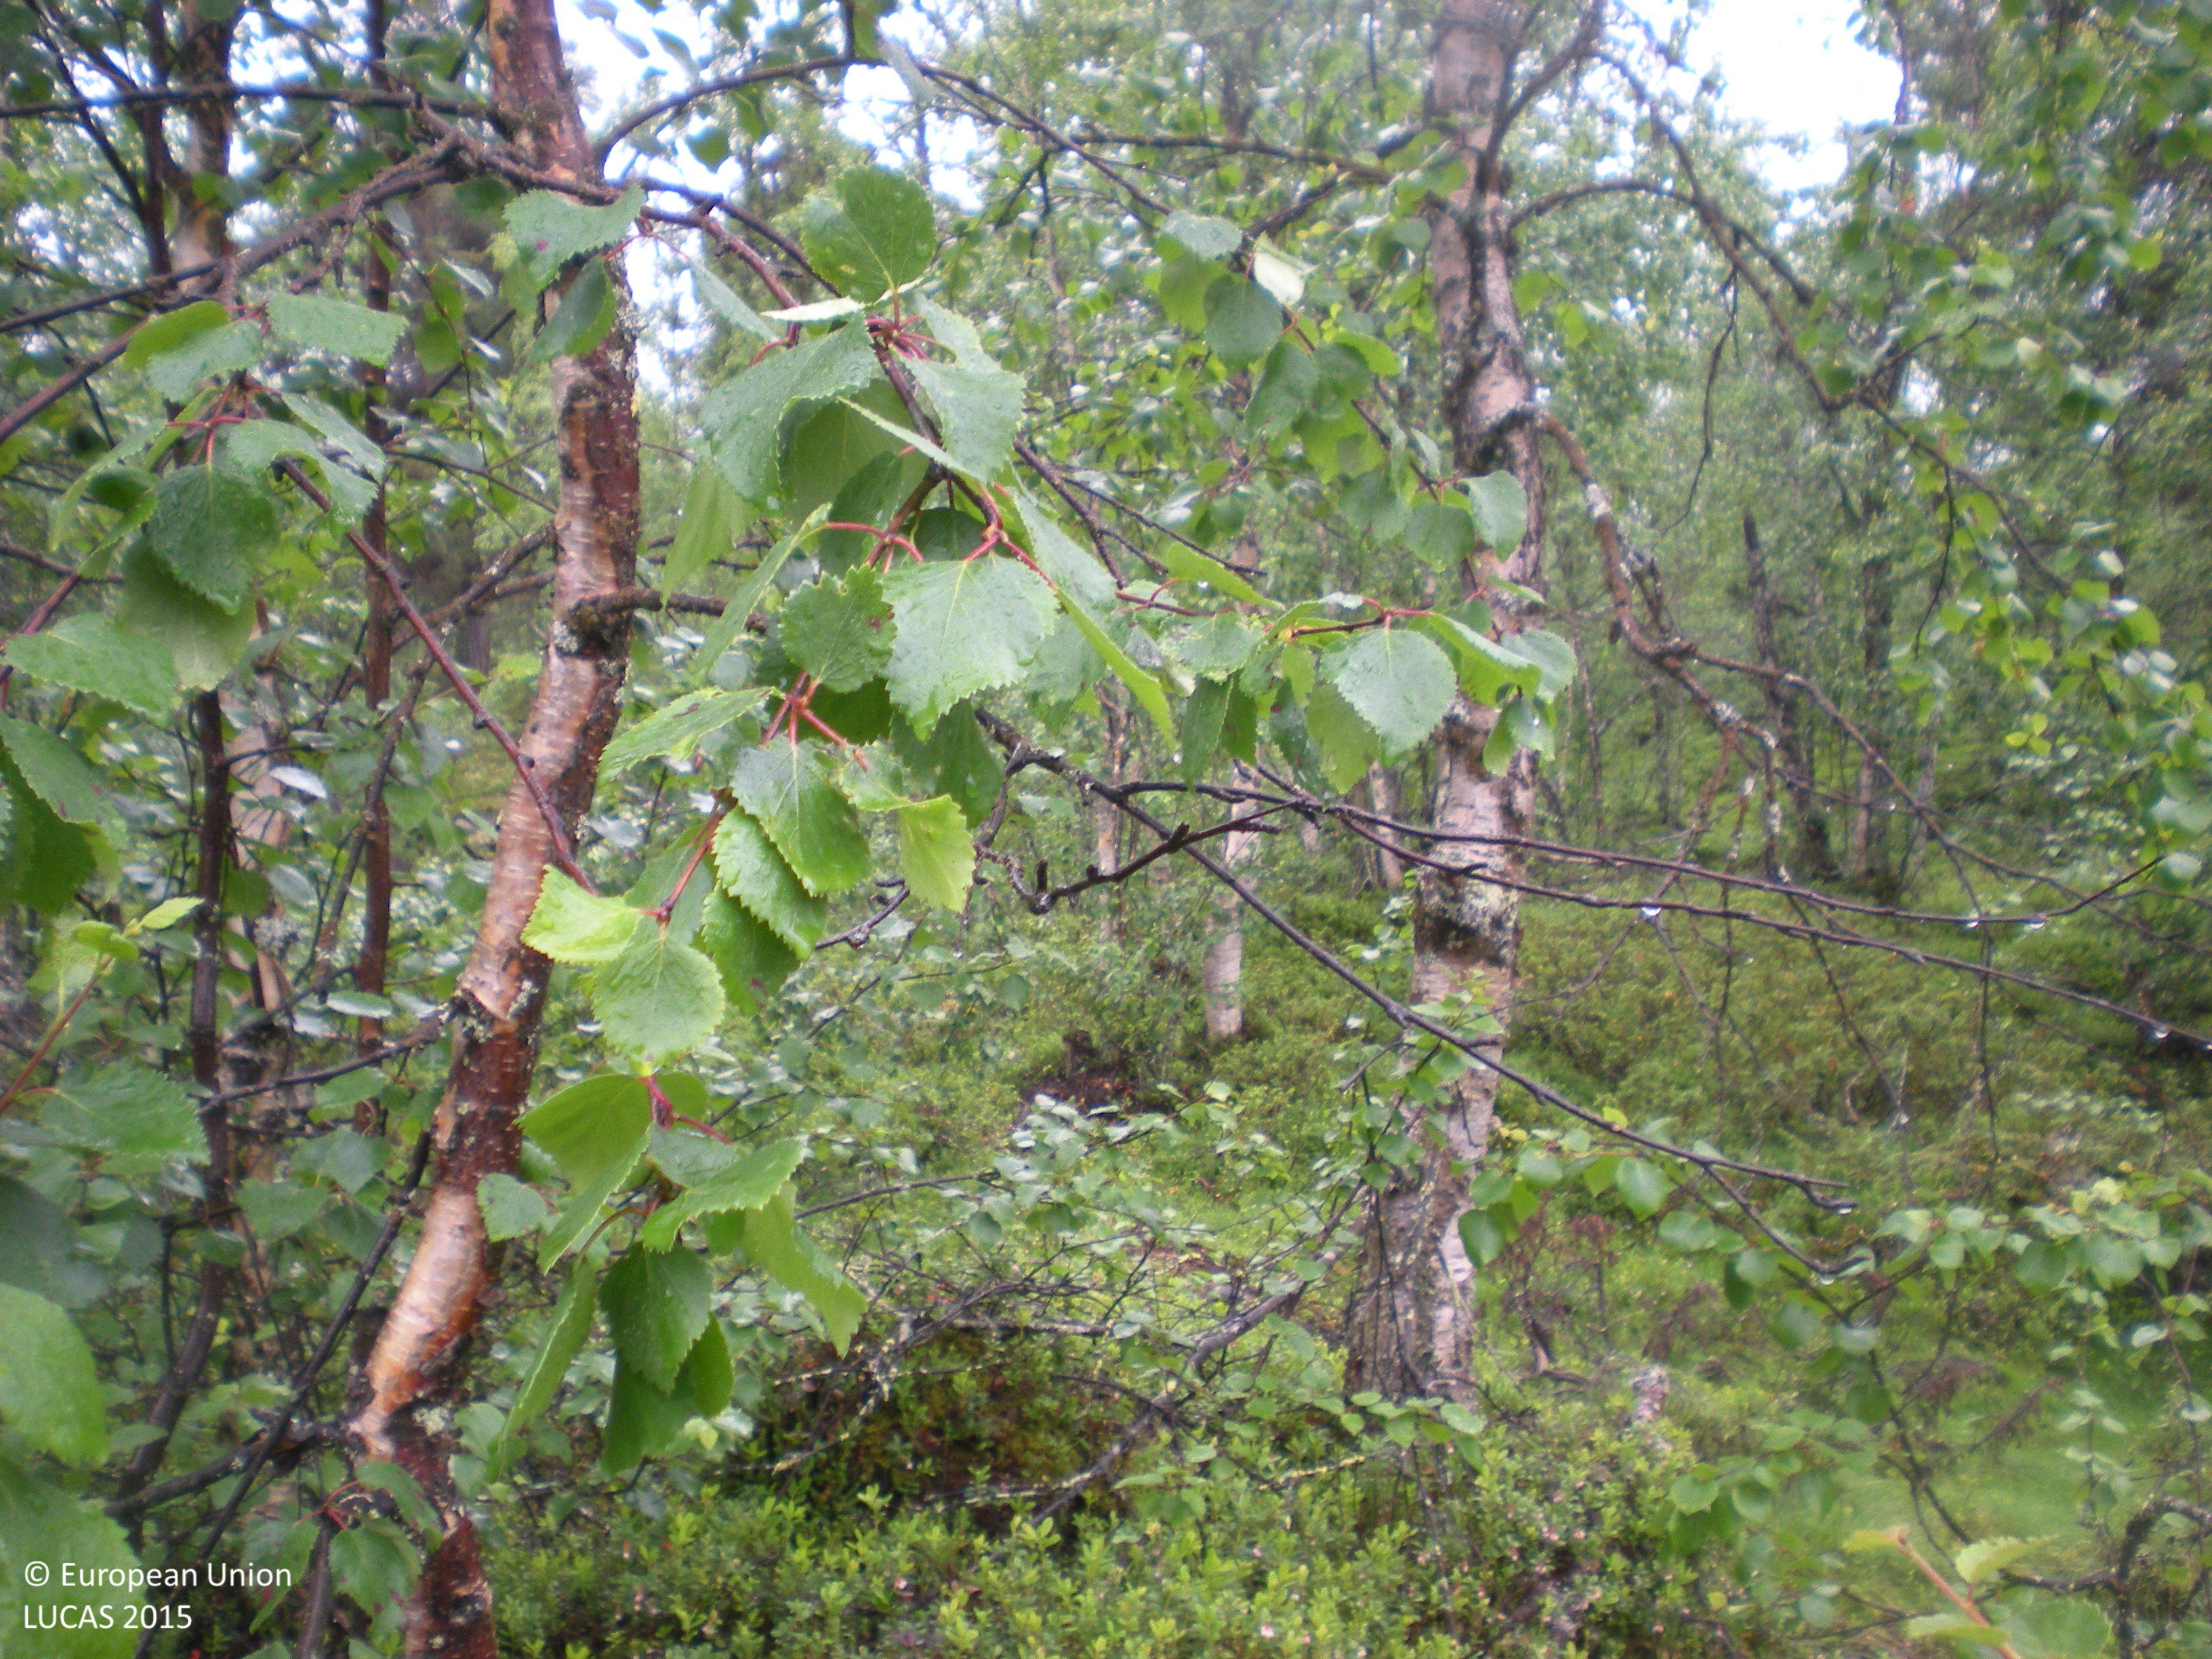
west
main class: Woodland
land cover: Broadleaved woodland
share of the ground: 25 - 50 %
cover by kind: broadleaved forest trees 40 %, shrubs 35 %, herbaceous plants 15 %, consolidated bare surface 10 %
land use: Forestry
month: August
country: SE
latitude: 66.3693
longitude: 17.7998
